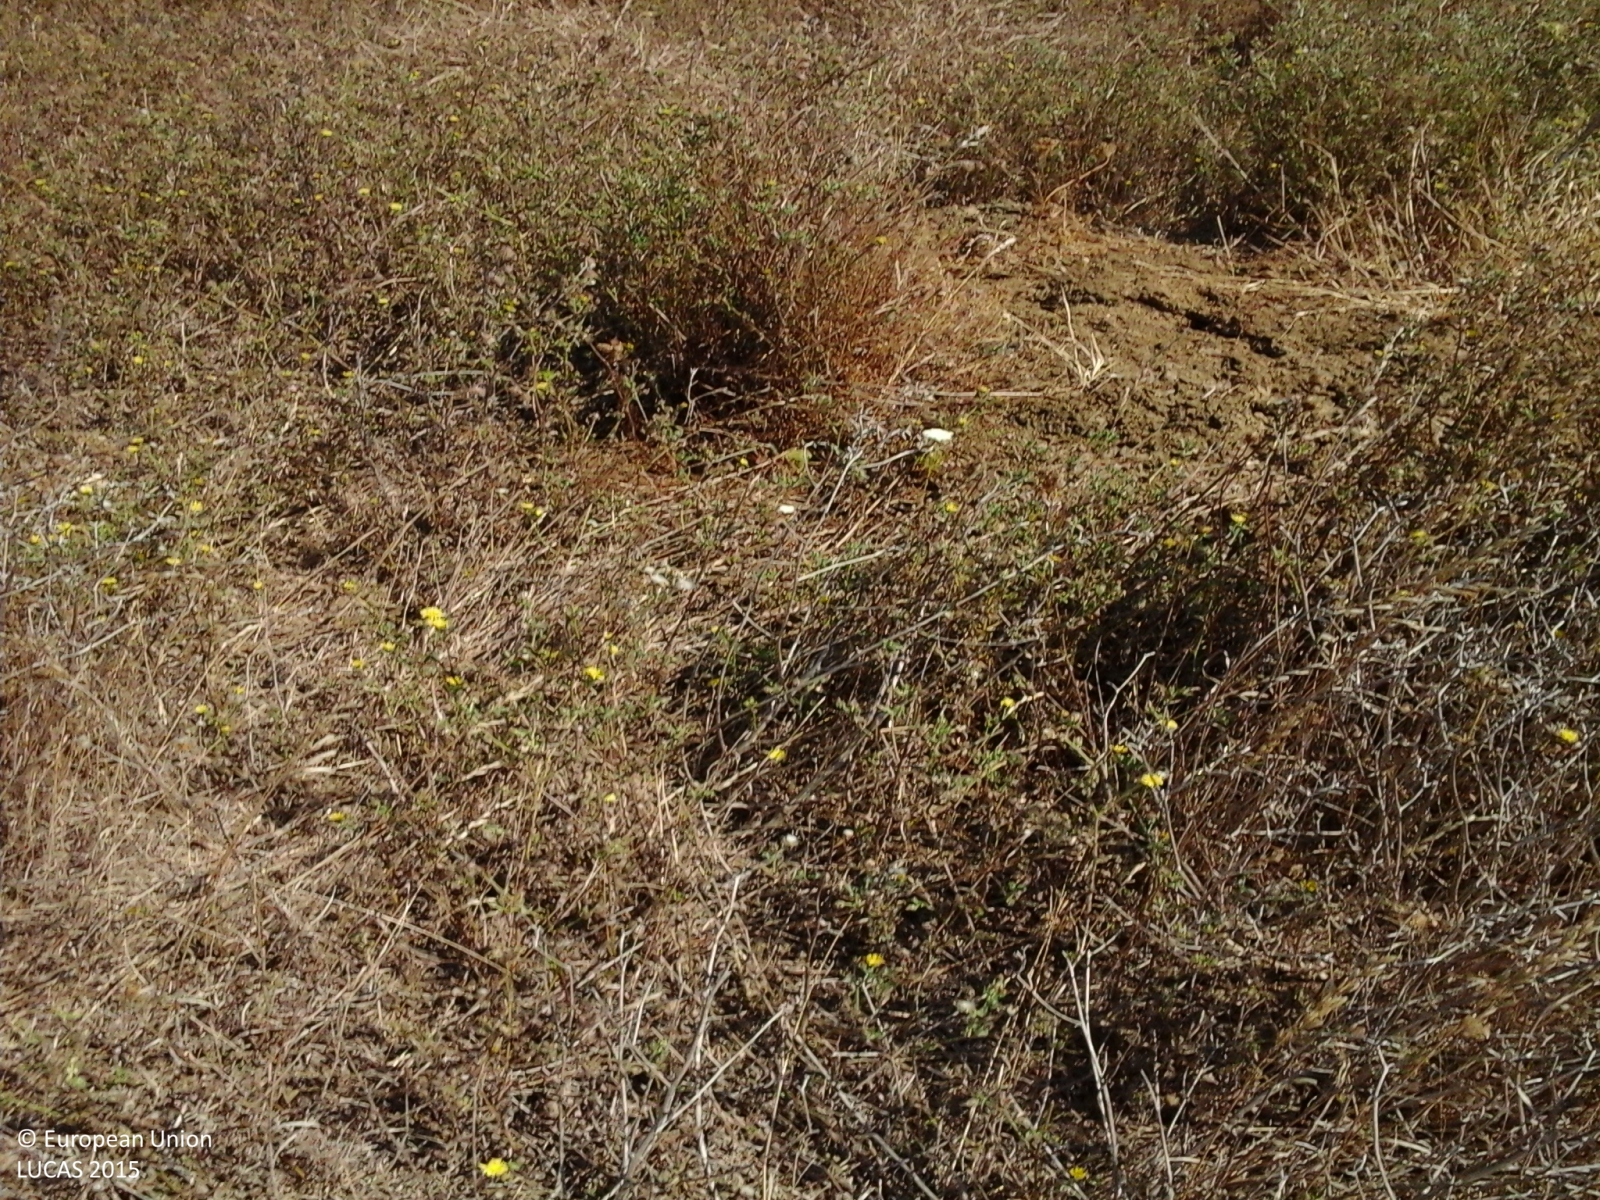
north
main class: Grassland
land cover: Spontaneously vegetated surfaces
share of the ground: > 75 %
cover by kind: herbaceous plants 100 %
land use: Fallow land
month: July
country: IT
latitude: 37.1089
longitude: 14.2093
